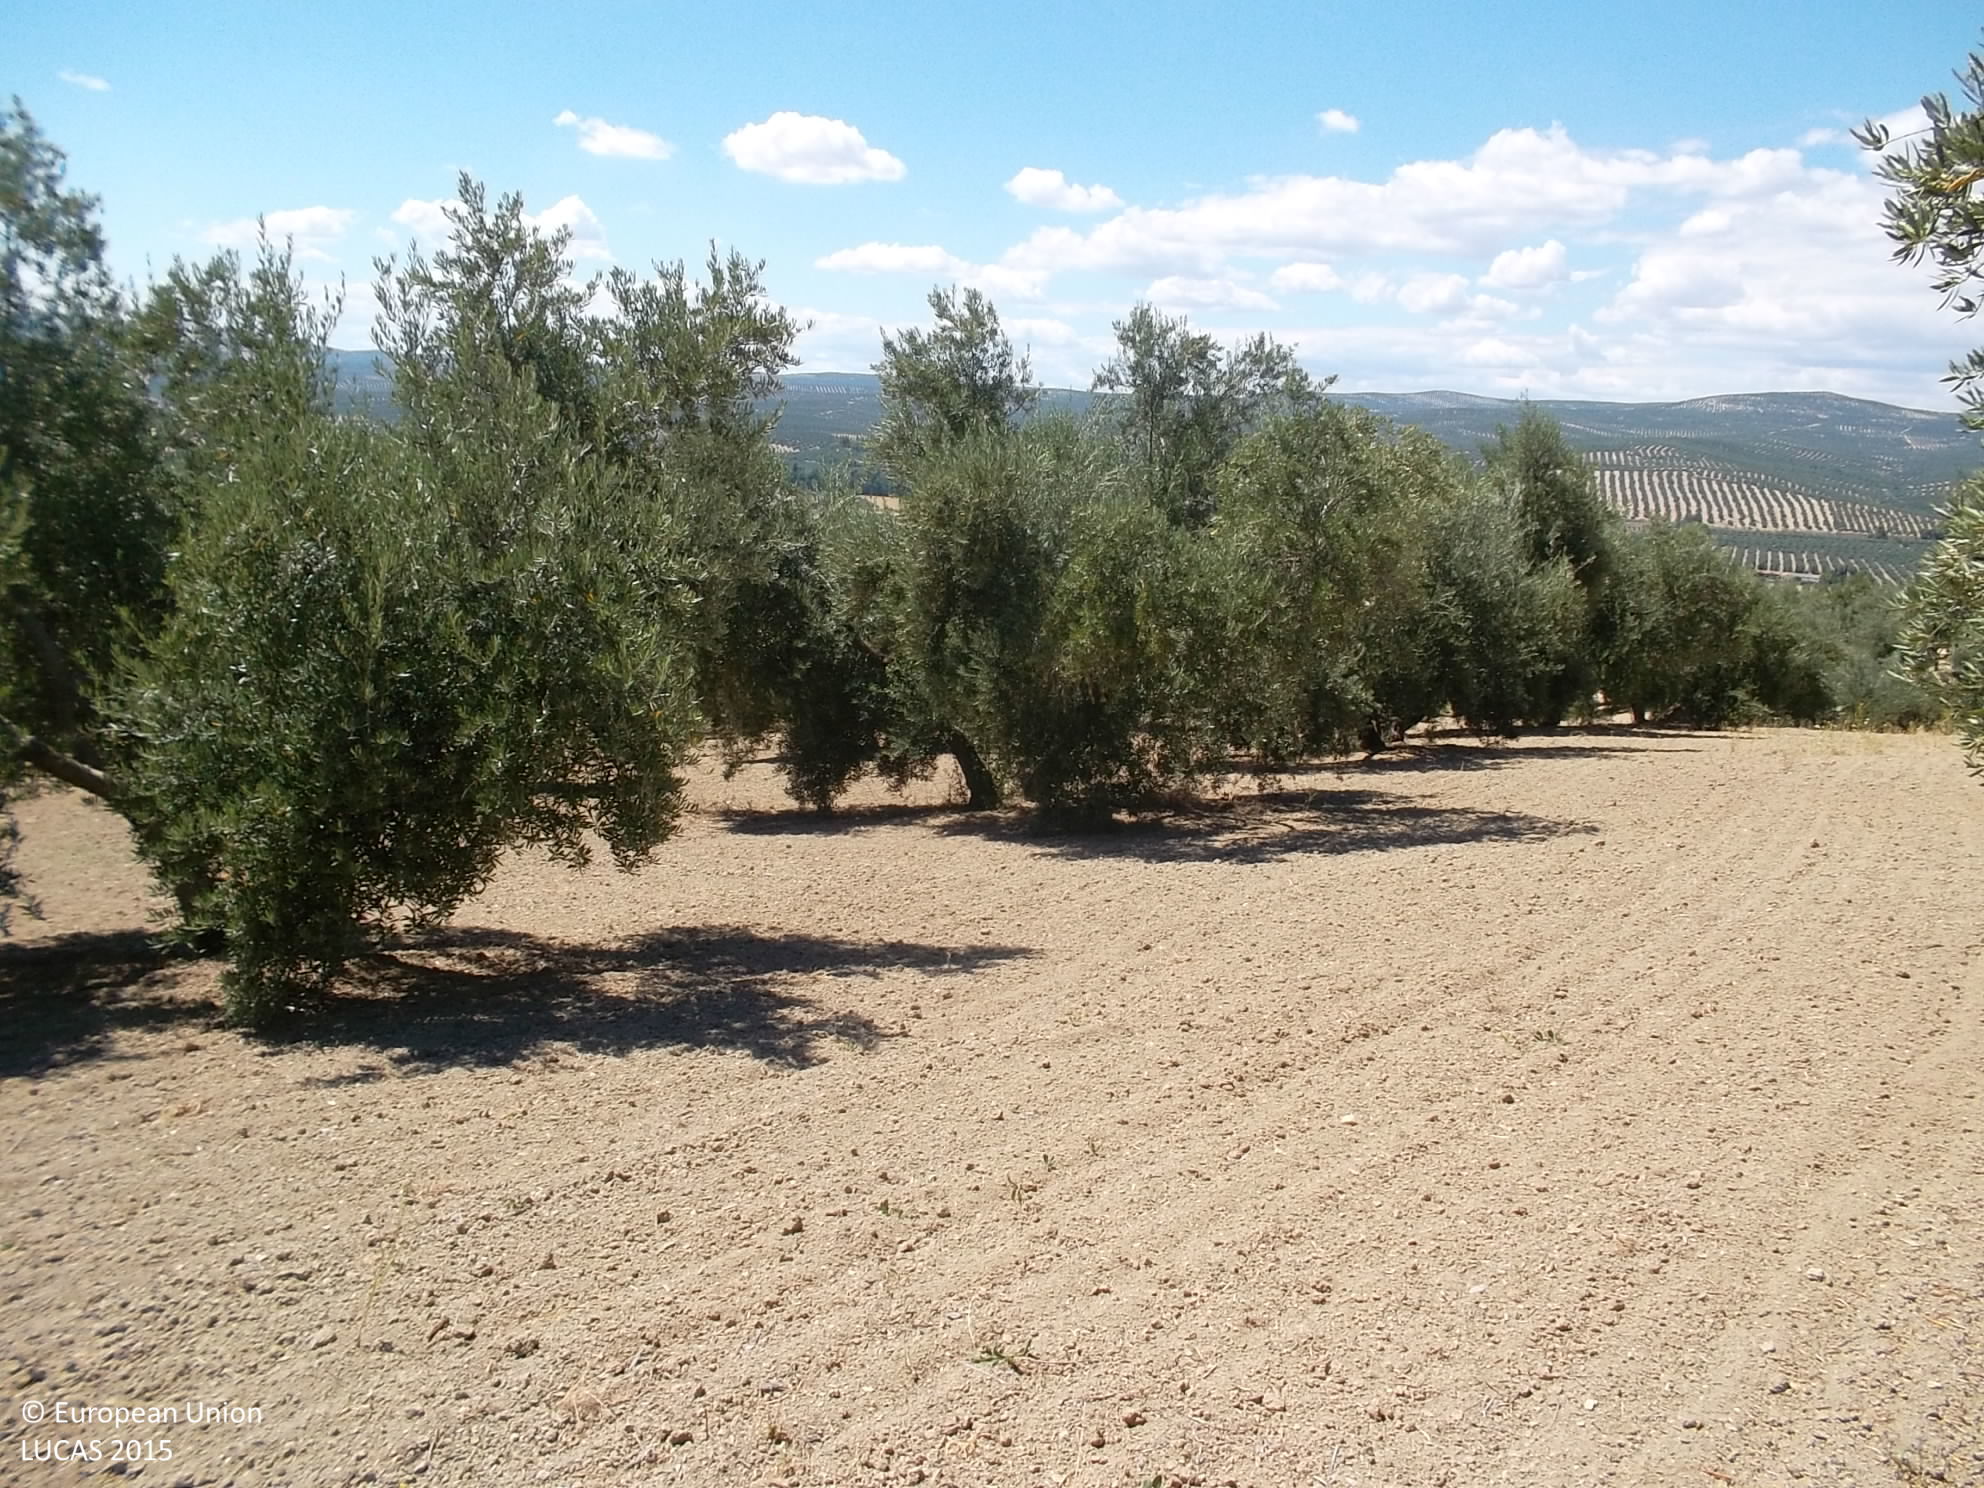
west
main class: Cropland
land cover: Olive groves
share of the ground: 25 - 50 %
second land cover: Other bare soil
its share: > 75 %
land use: Agriculture (excluding fallow land and kitchen gardens)
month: June
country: ES
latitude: 38.0340
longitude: -3.0655
